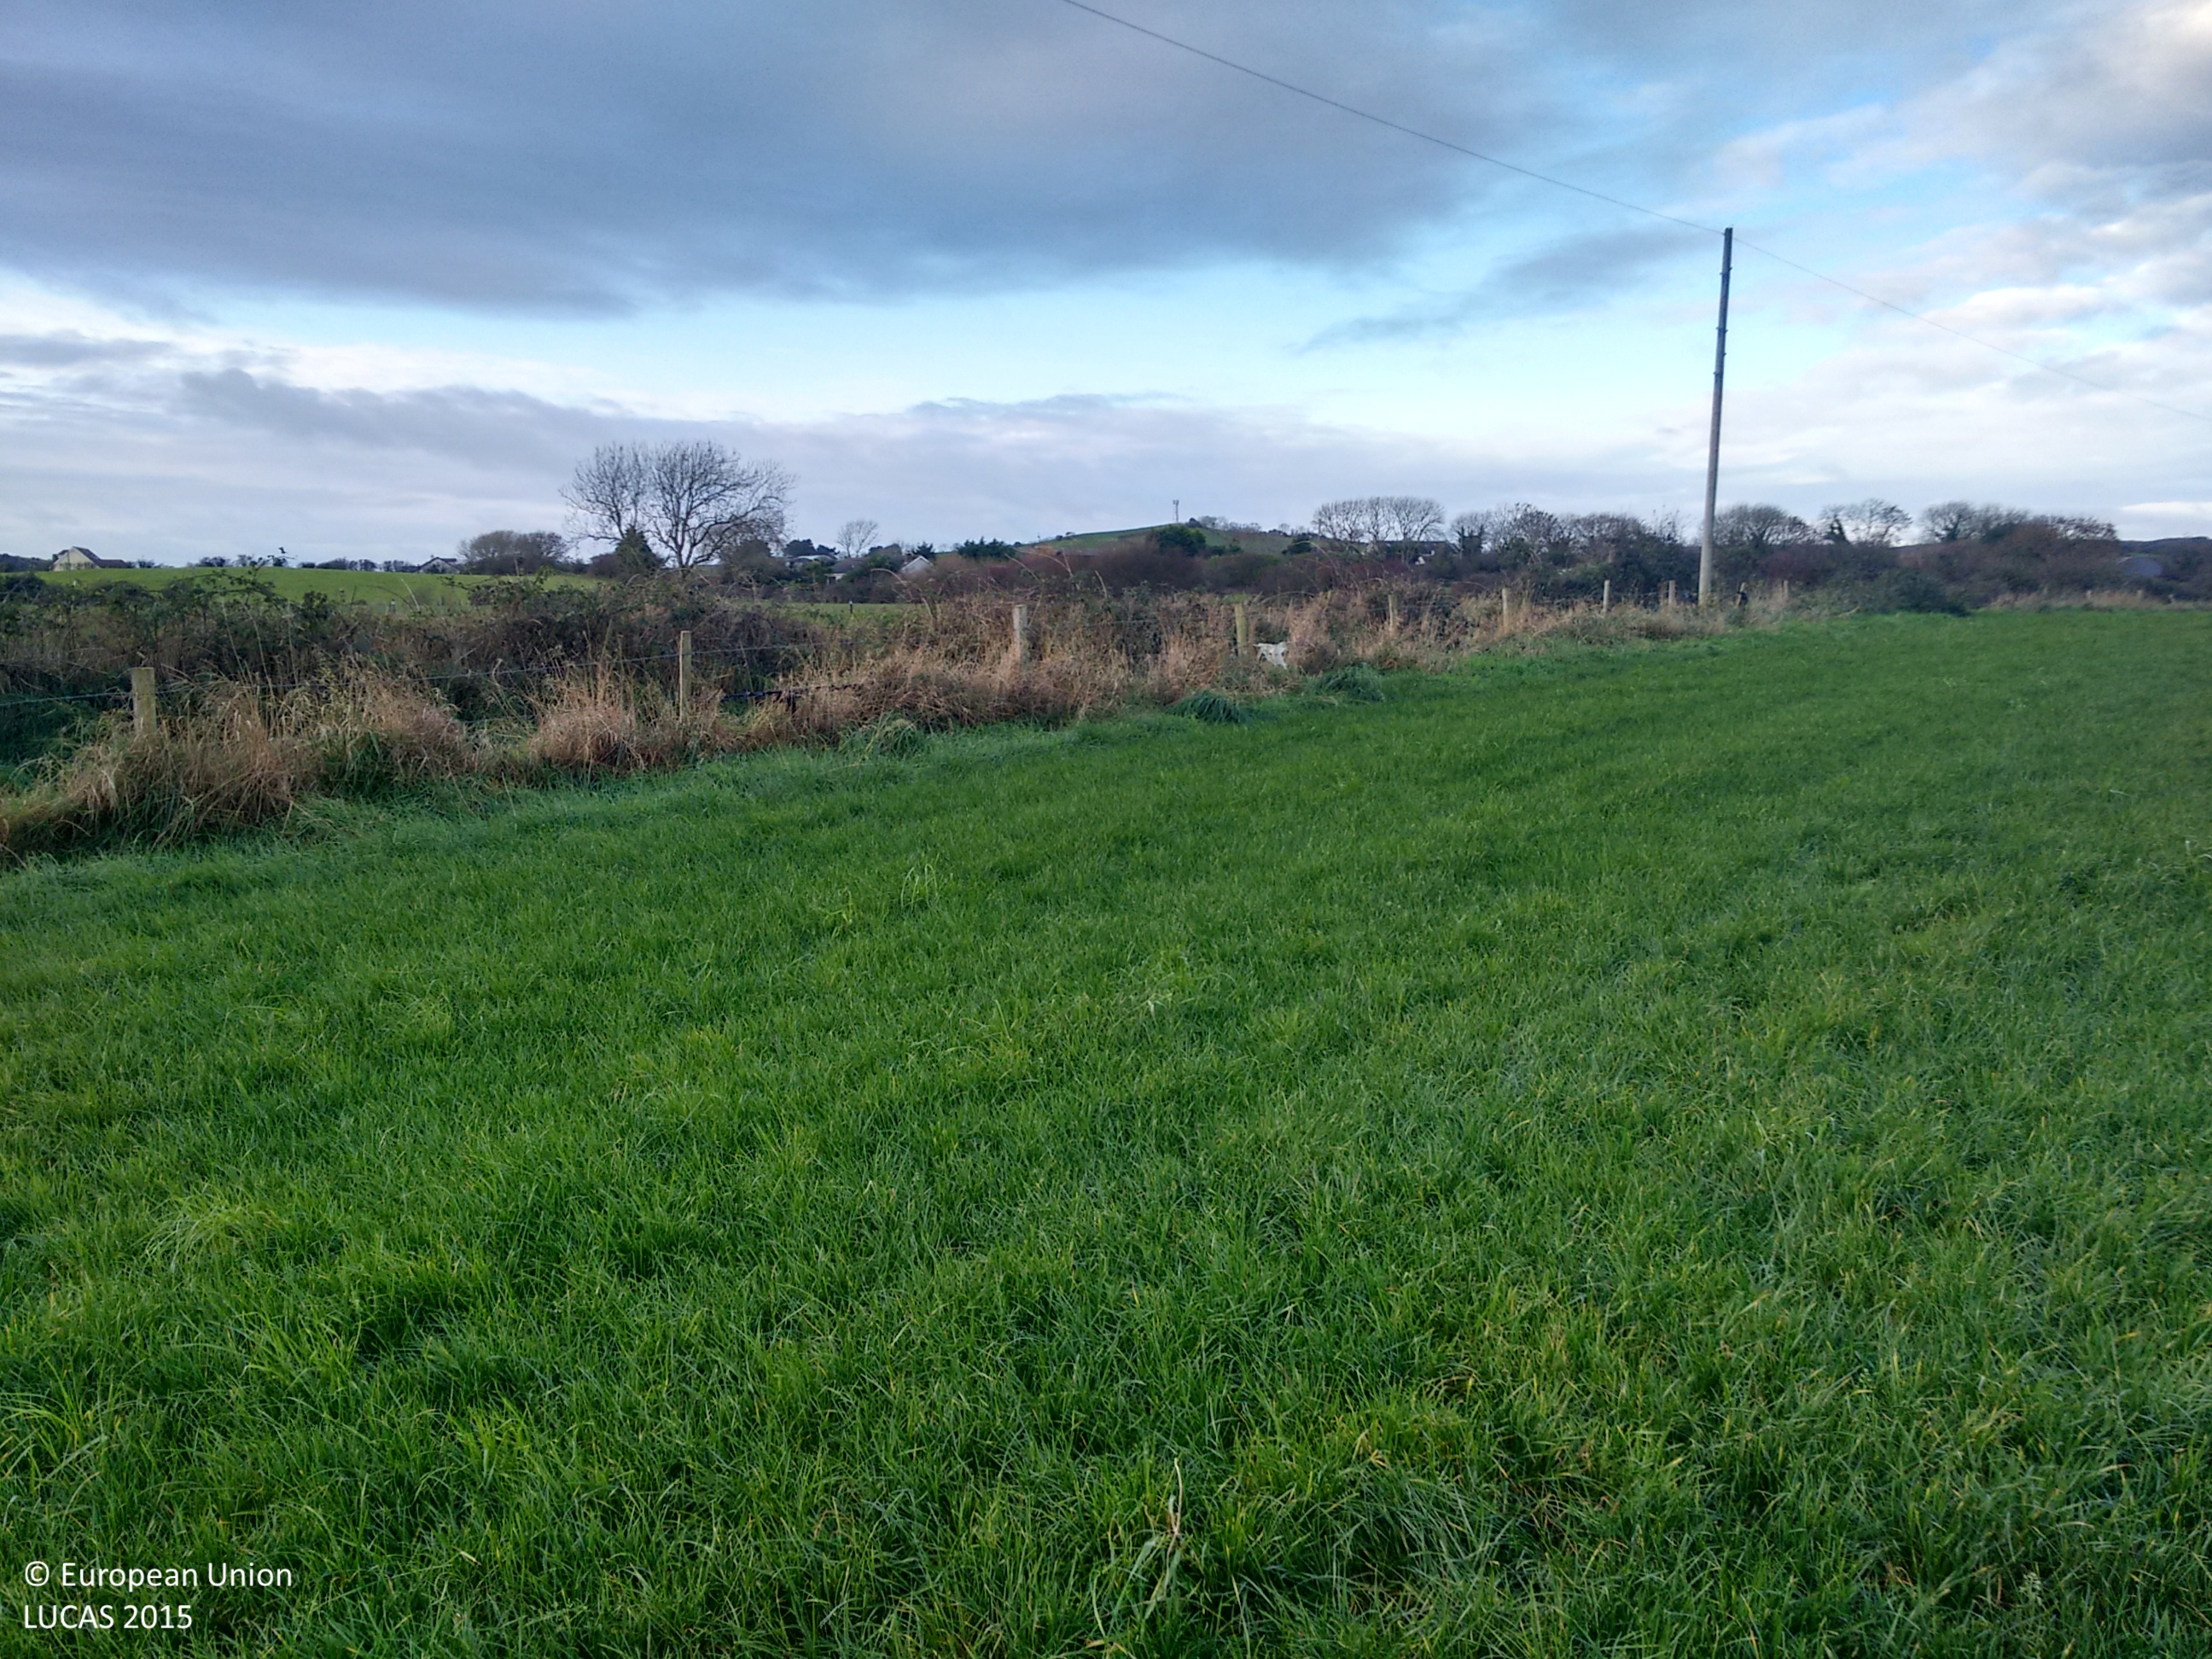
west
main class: Grassland
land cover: Grassland without tree/shrub cover
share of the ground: > 75 %
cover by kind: herbaceous plants 100 %
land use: Agriculture (excluding fallow land and kitchen gardens)
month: November
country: GB
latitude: 54.3919
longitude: -5.5133
